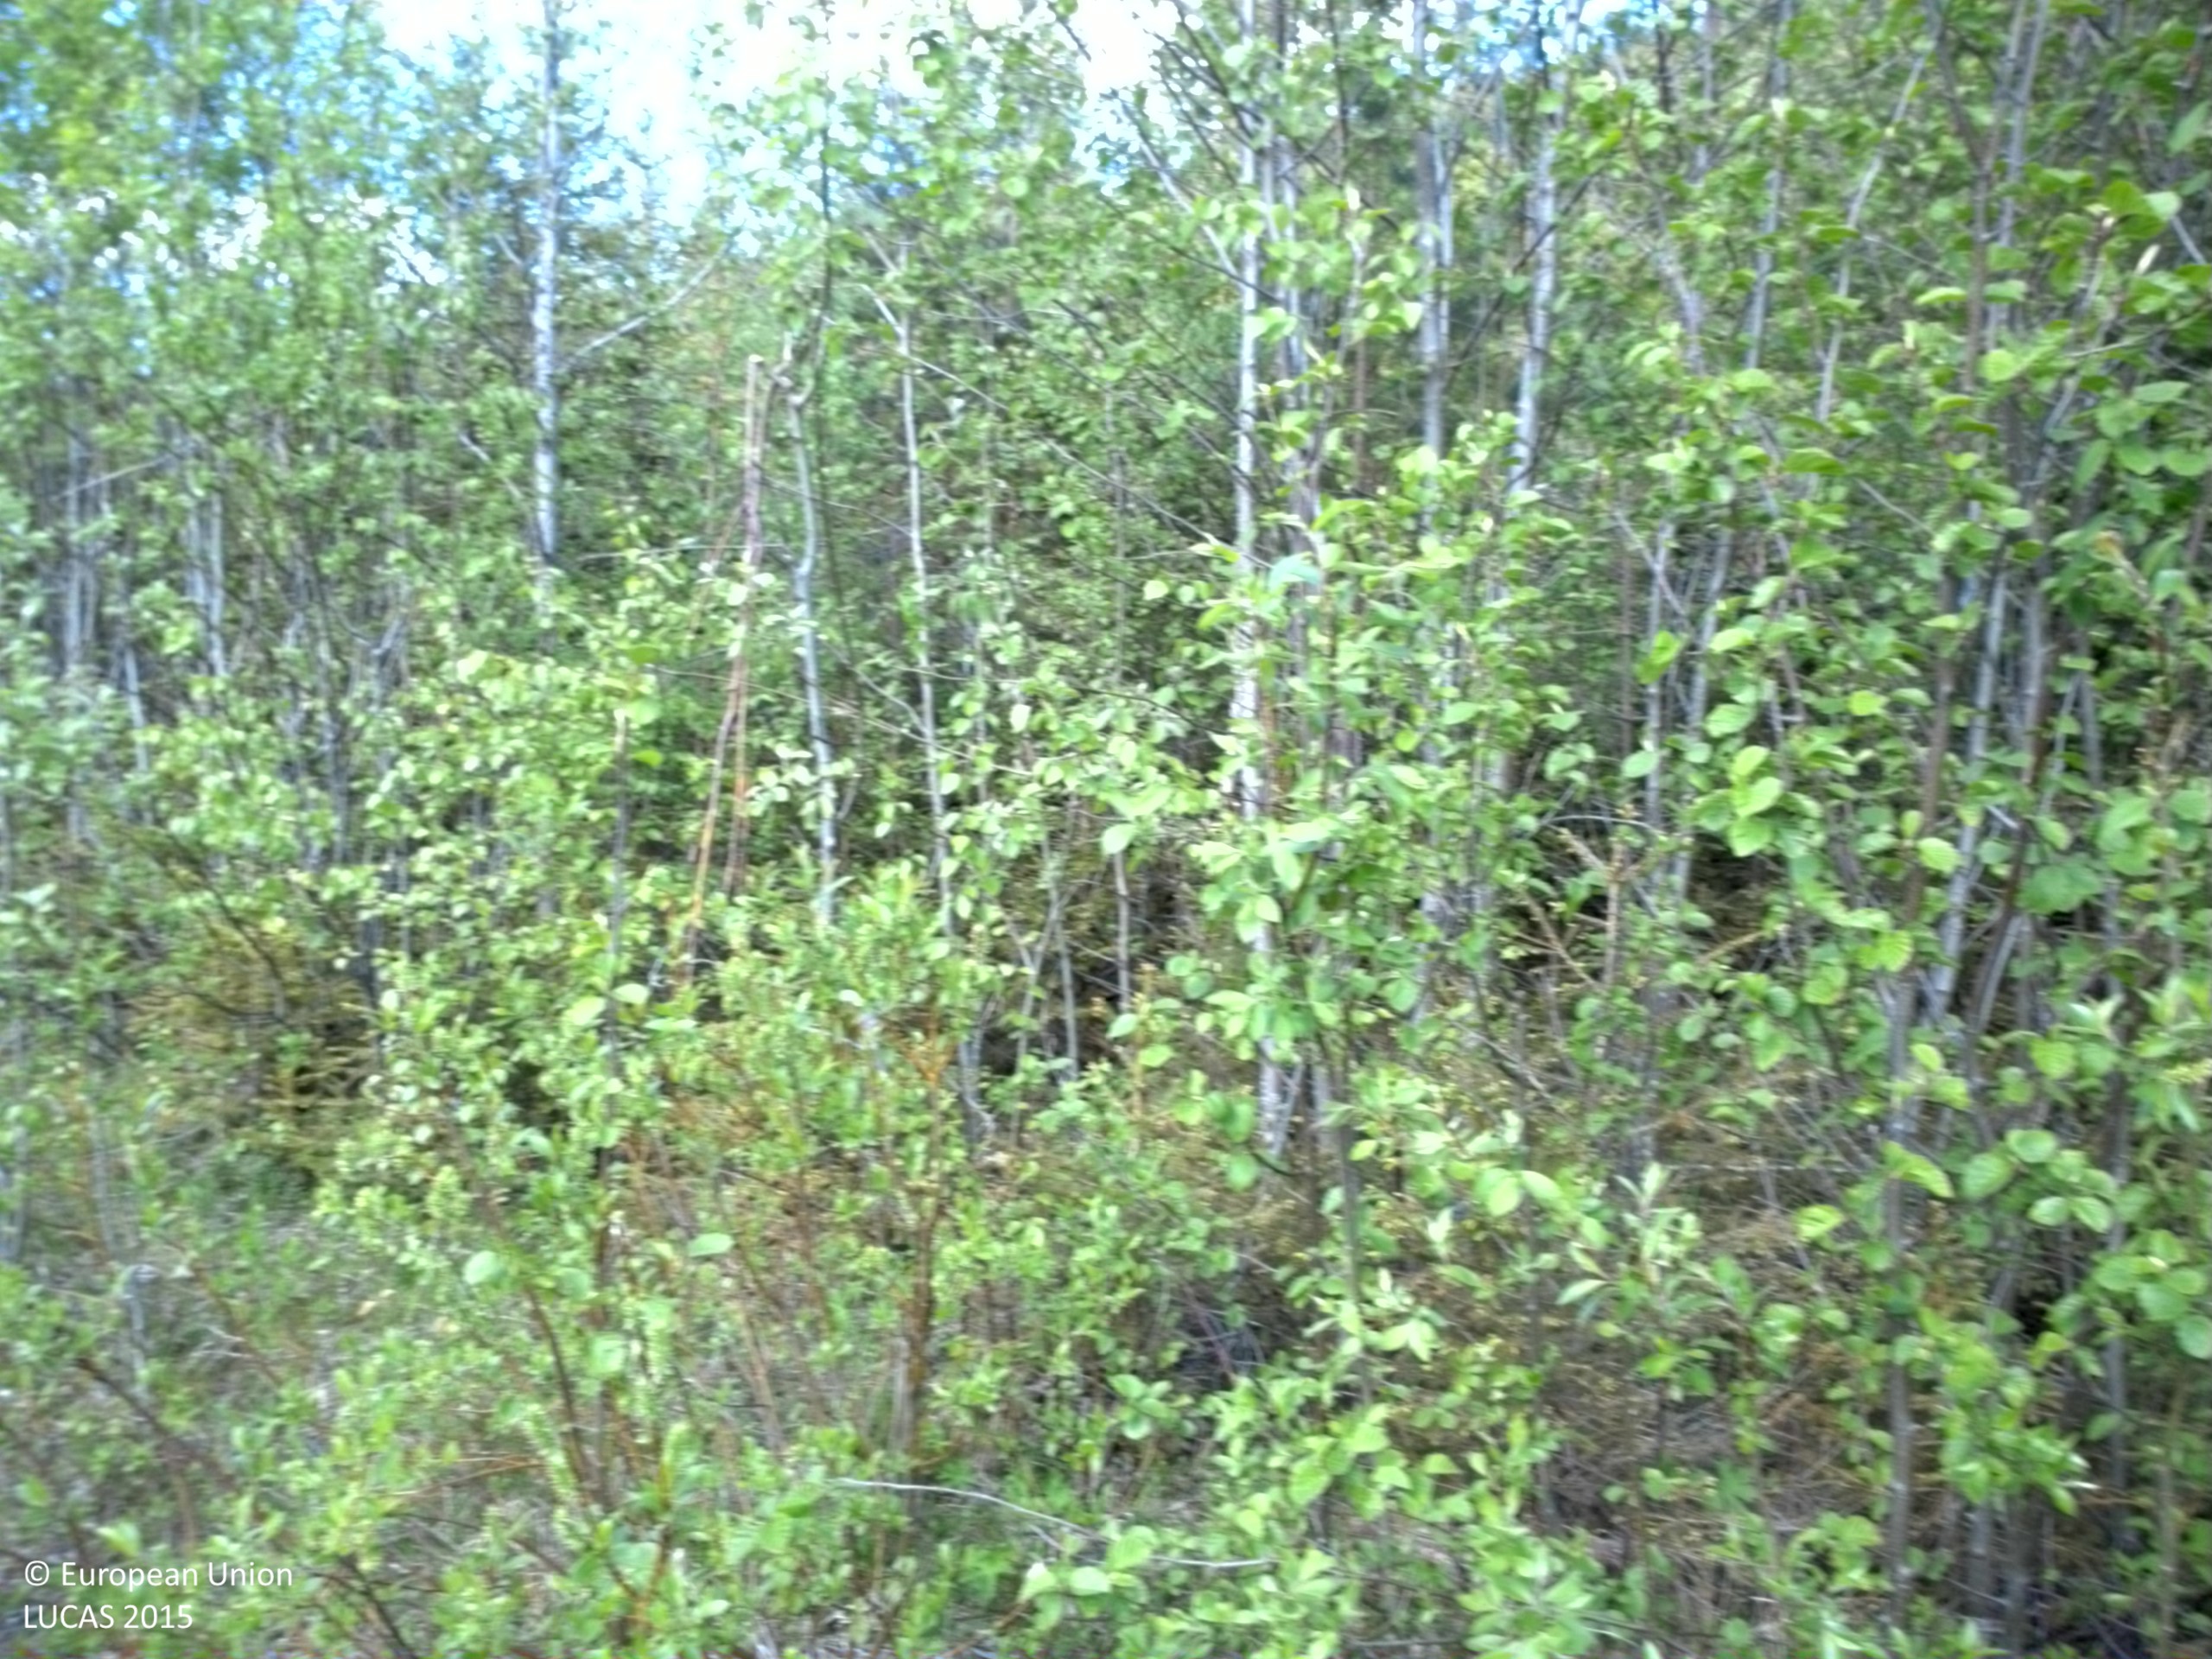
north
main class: Woodland
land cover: Spruce dominated coniferous woodland
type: boreal forest
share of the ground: 50 - 75 %
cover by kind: coniferous forest trees 70 %, herbaceous plants 30 %
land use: Forestry
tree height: > 5 m
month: June
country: SE
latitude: 63.0563
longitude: 17.1968
